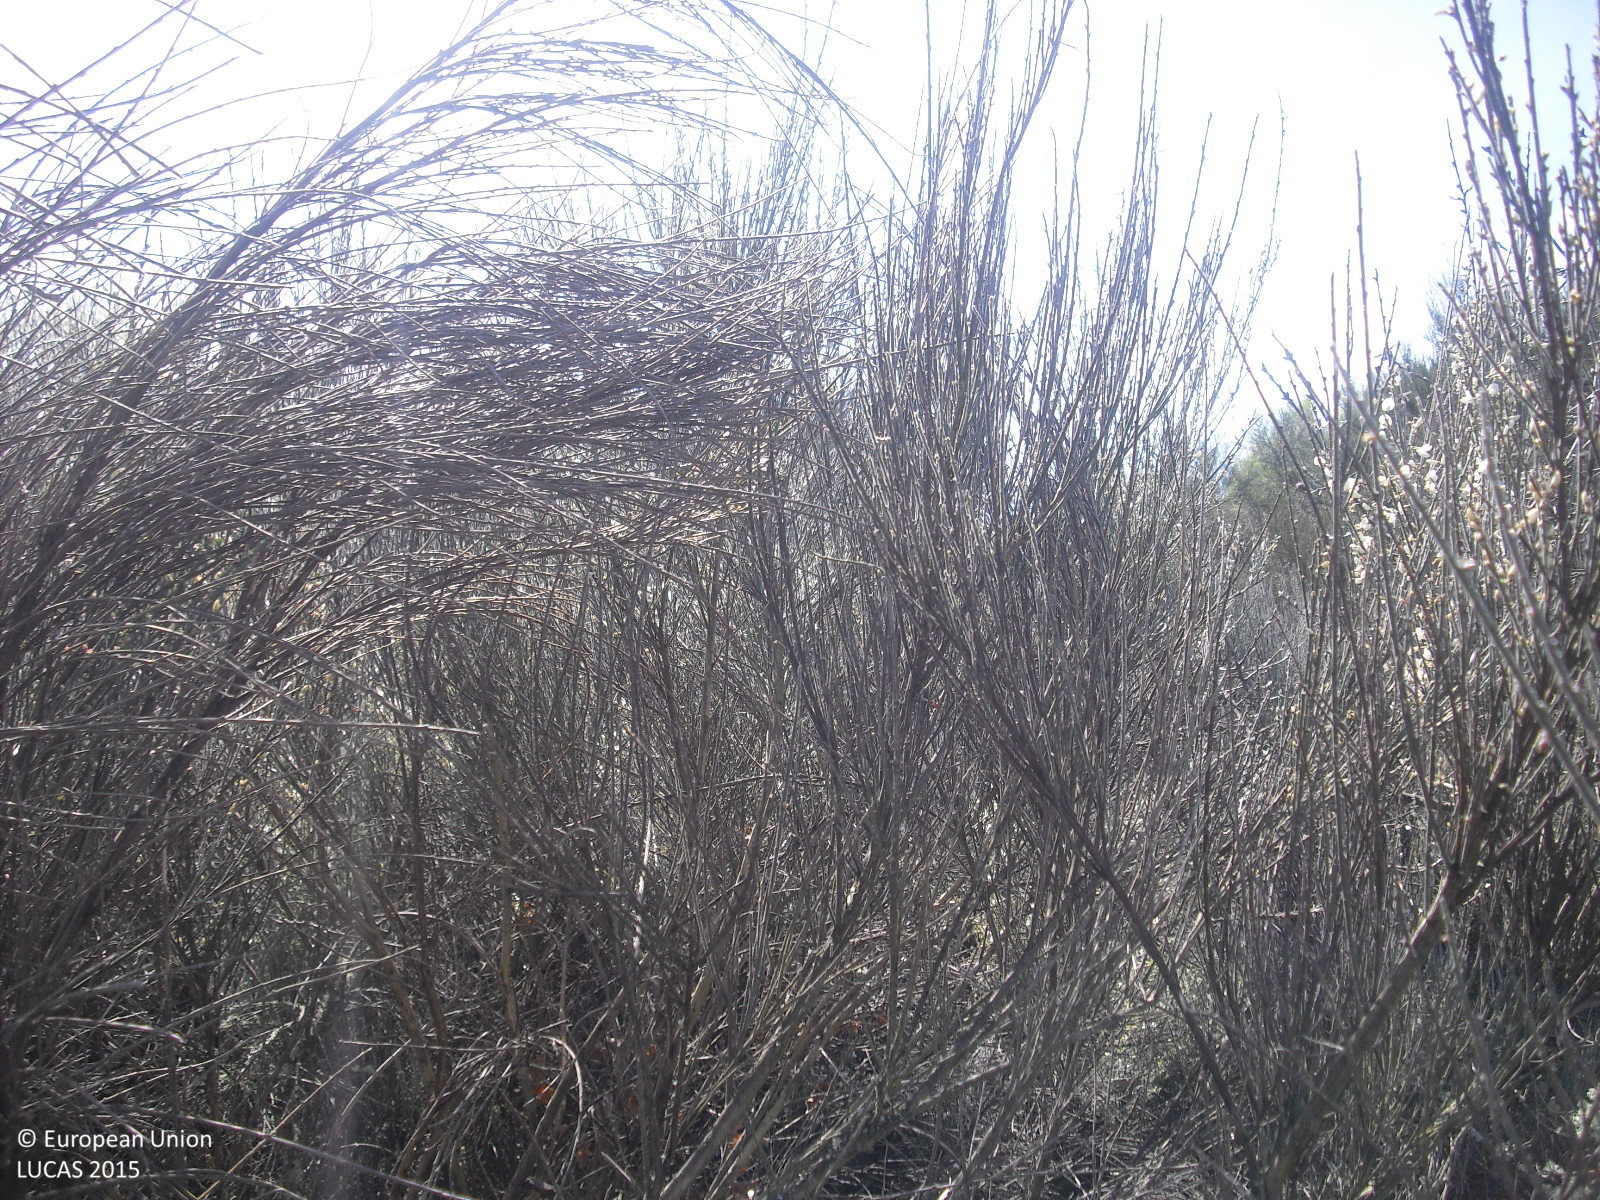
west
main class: Artificial land
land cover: Non built-up linear features
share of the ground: > 75 %
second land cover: Grassland without tree/shrub cover
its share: > 75 %
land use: Road transport
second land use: Agriculture (excluding fallow land and kitchen gardens)
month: April
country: ES
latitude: 41.9574
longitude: -7.6441
